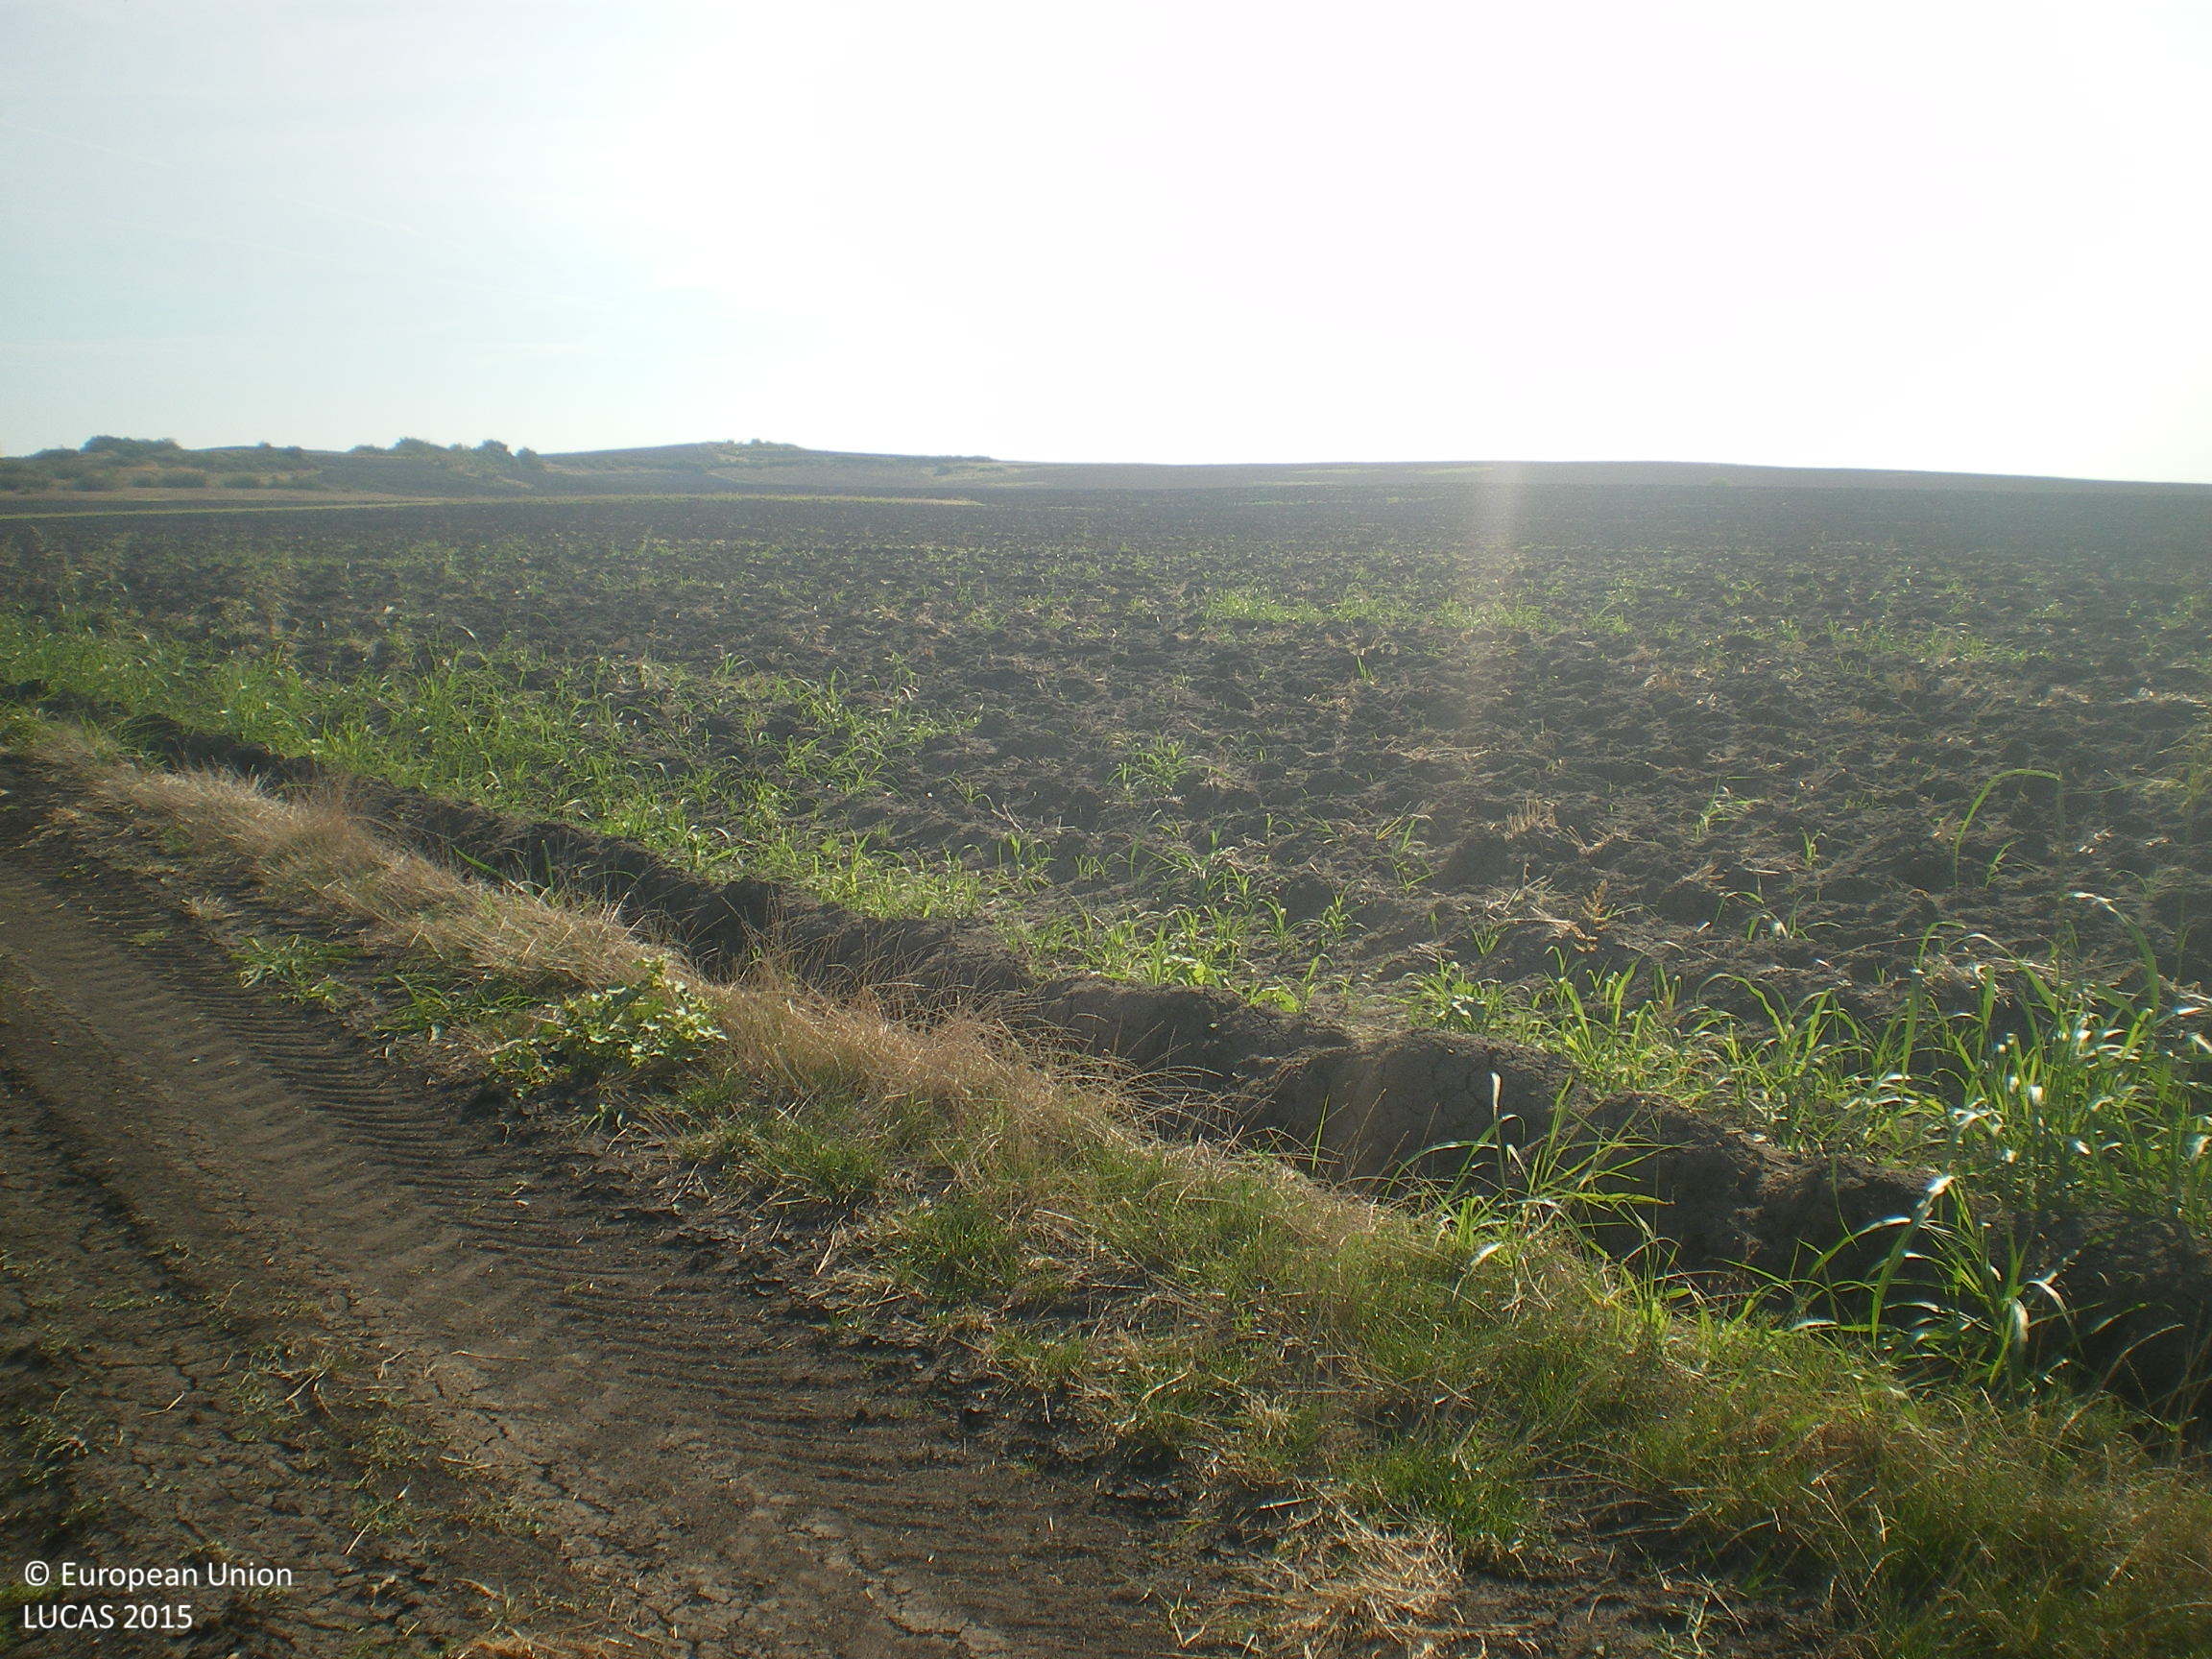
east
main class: Cropland
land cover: Sunflower
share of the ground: > 75 %
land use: Agriculture (excluding fallow land and kitchen gardens)
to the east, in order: Sunflower; Grass margins; Tracks; Grass margins; Common wheat
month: September
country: BG
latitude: 42.0871
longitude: 25.8983
